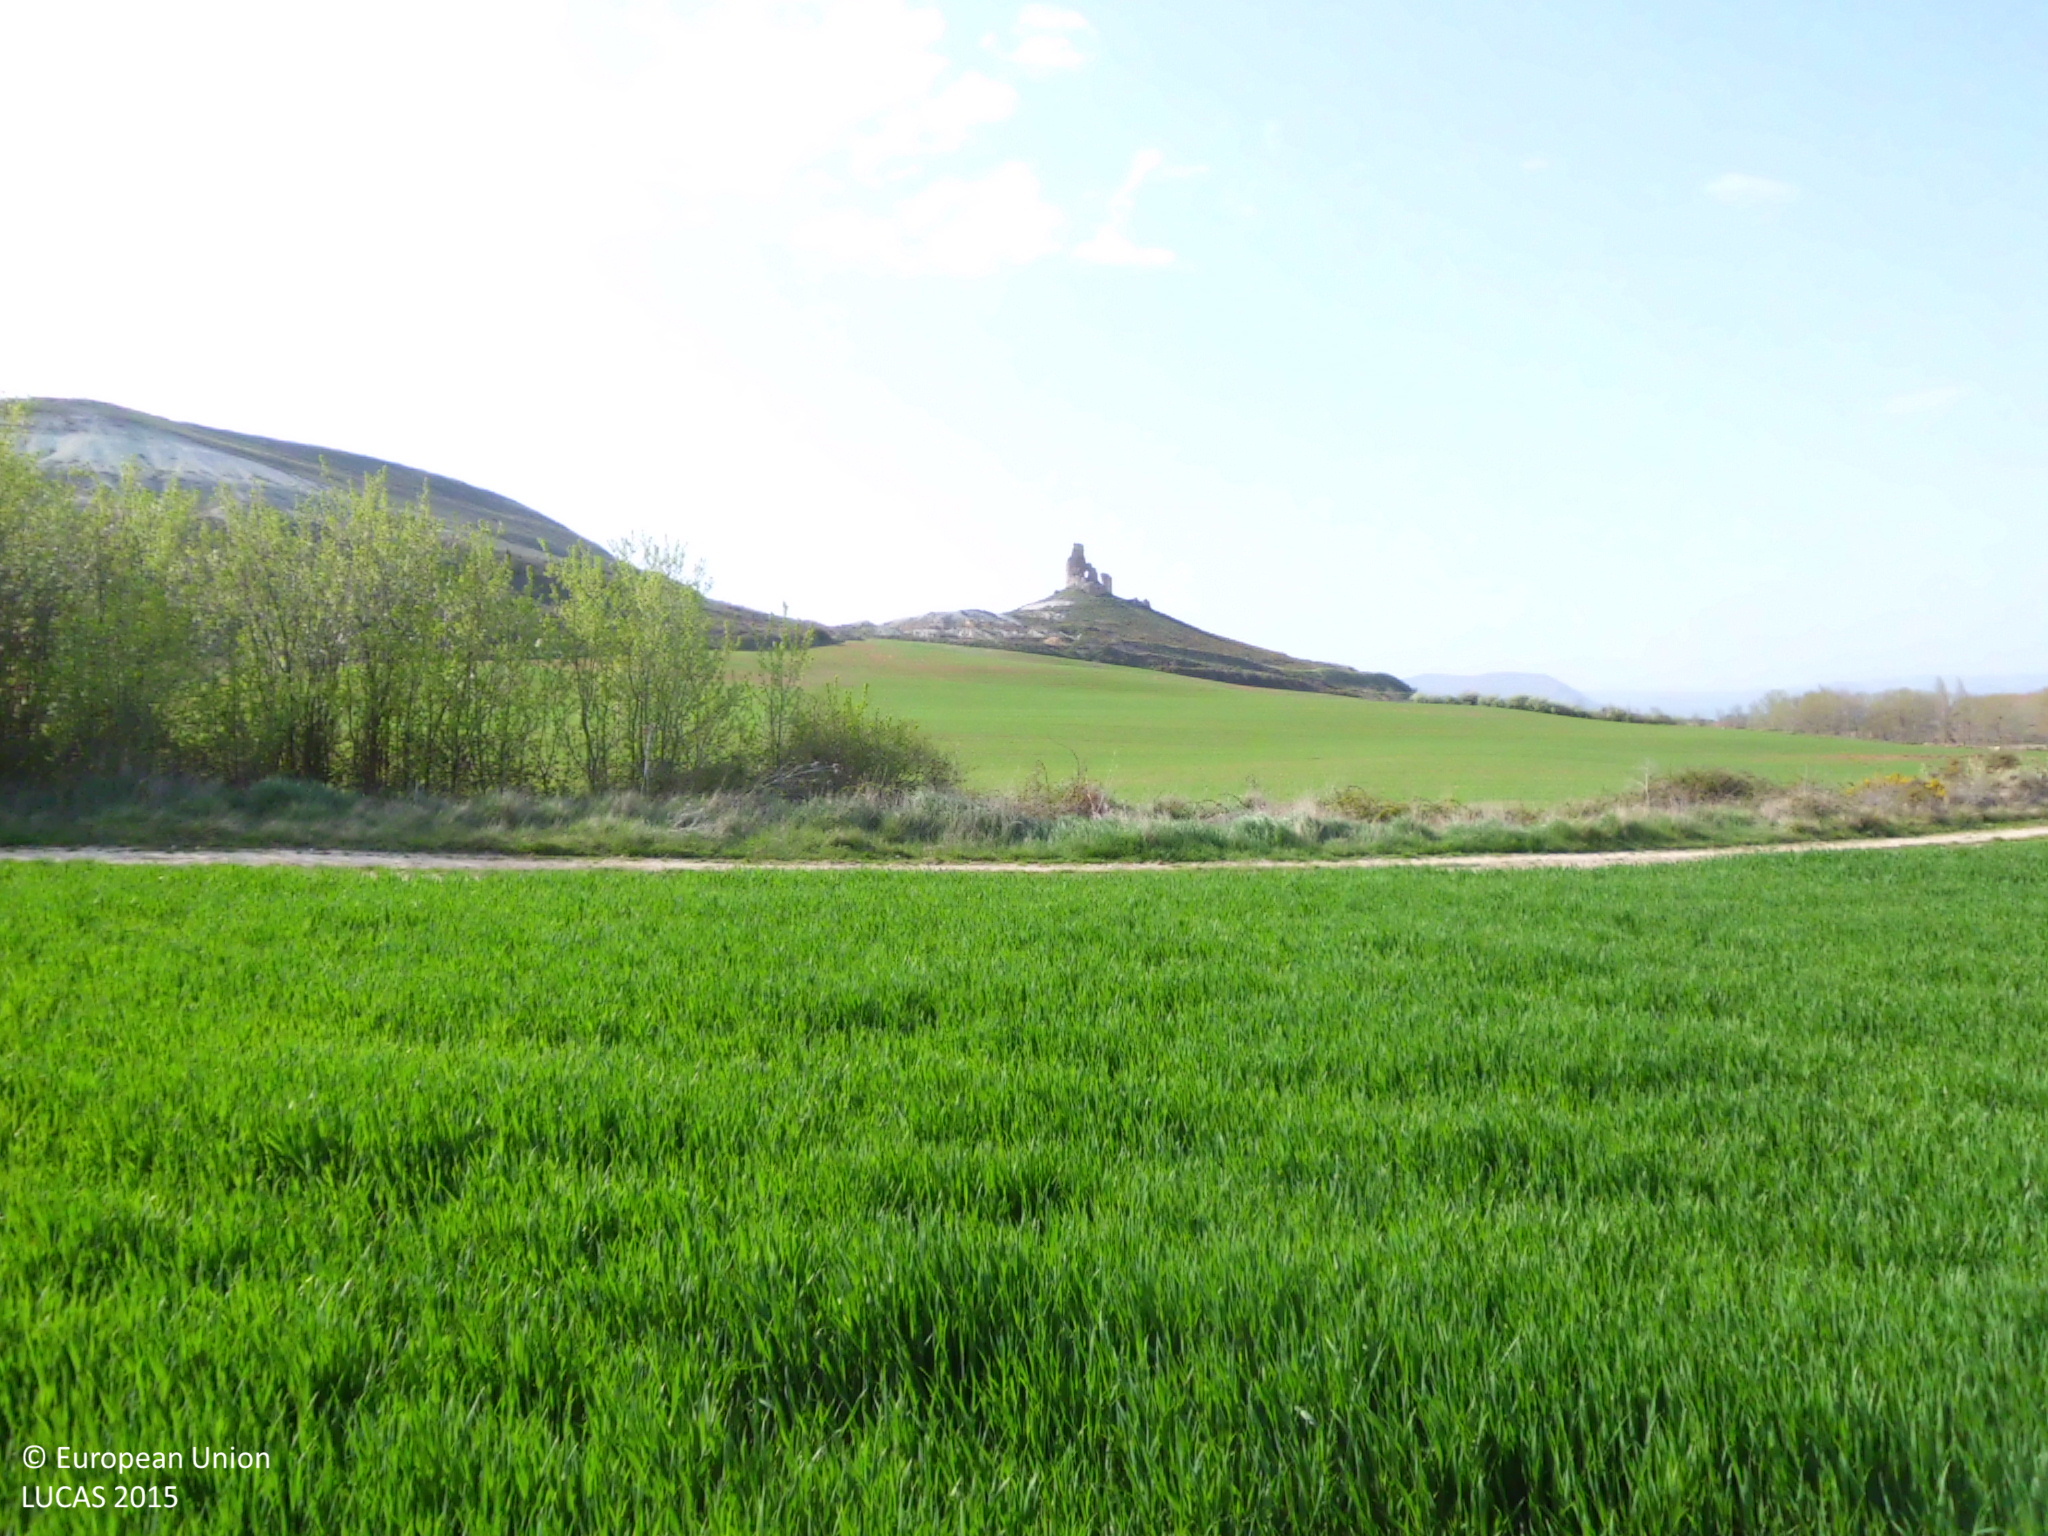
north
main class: Cropland
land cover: Common wheat
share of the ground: > 75 %
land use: Agriculture (excluding fallow land and kitchen gardens)
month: April
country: ES
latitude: 42.5752
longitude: -3.4485
